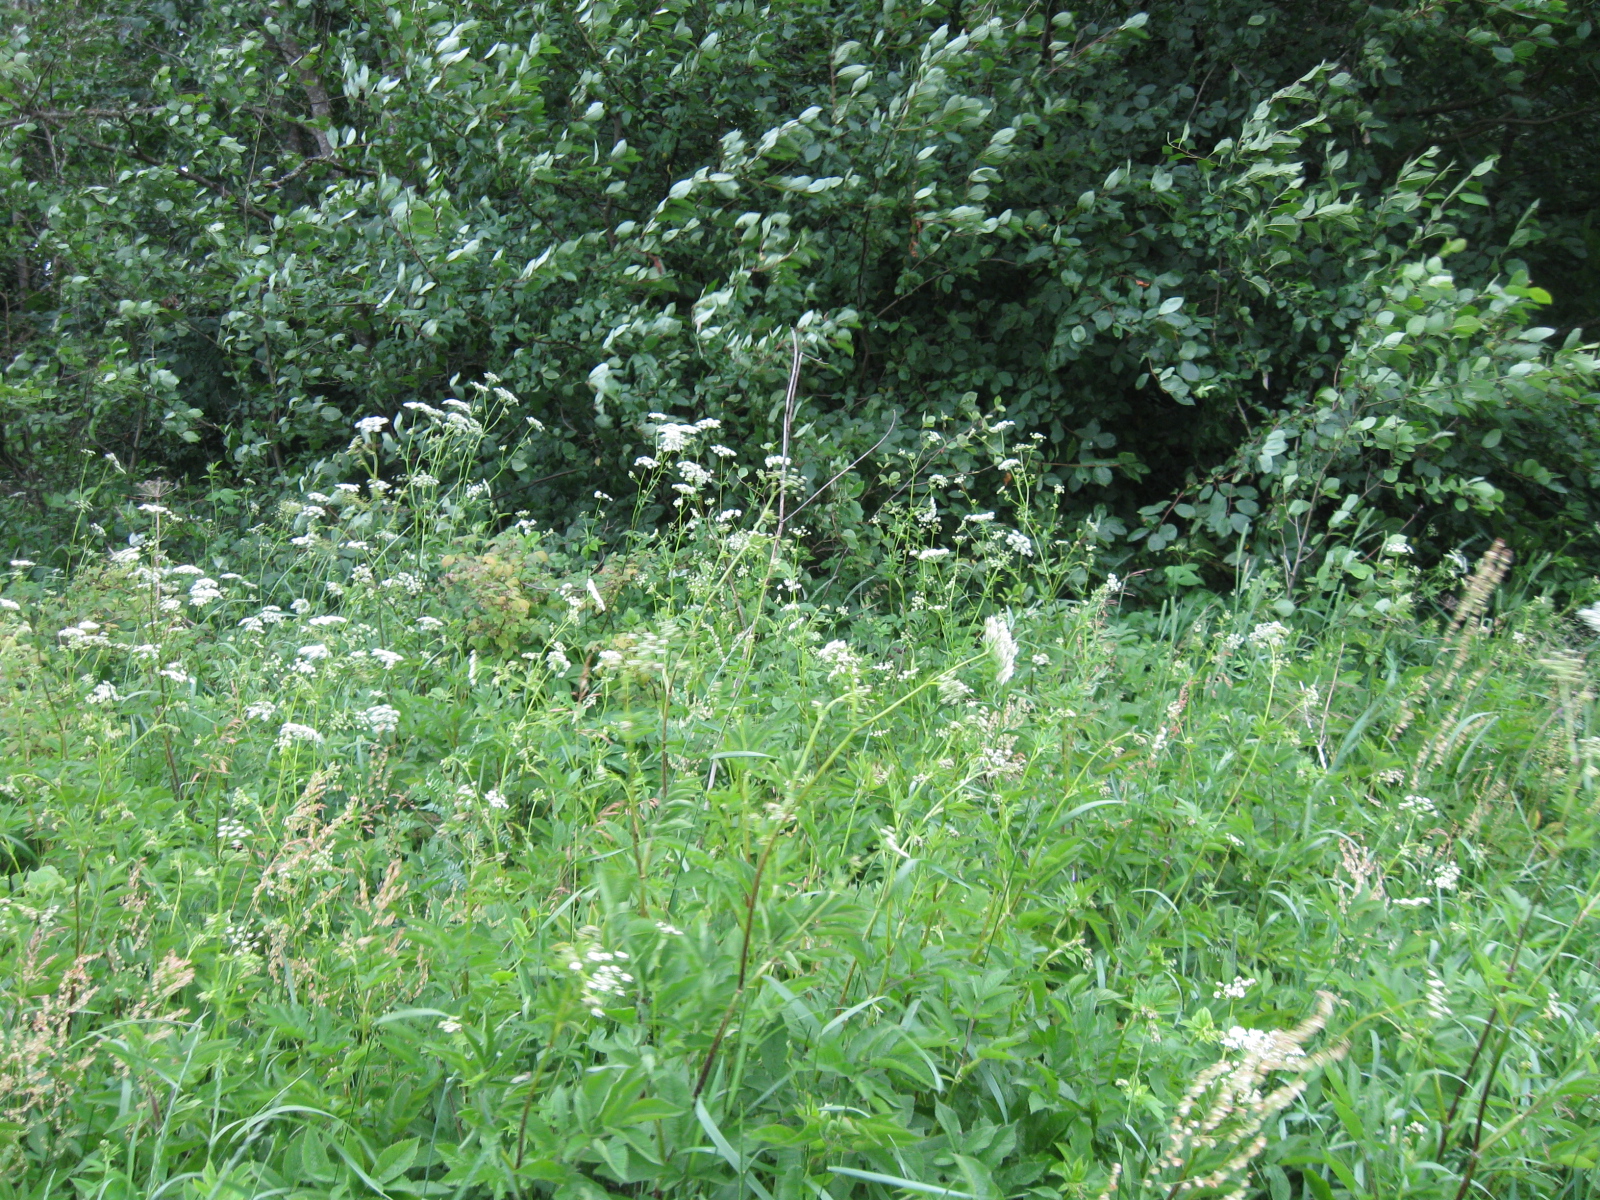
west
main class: Grassland
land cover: Grassland with sparse tree/shrub cover
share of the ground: > 75 %
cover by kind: herbaceous plants 90 %, broadleaved forest trees 5 %, shrubs 5 %
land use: Agriculture (excluding fallow land and kitchen gardens)
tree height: < 5 m
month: June
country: LT
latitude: 54.6236
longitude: 24.3643
